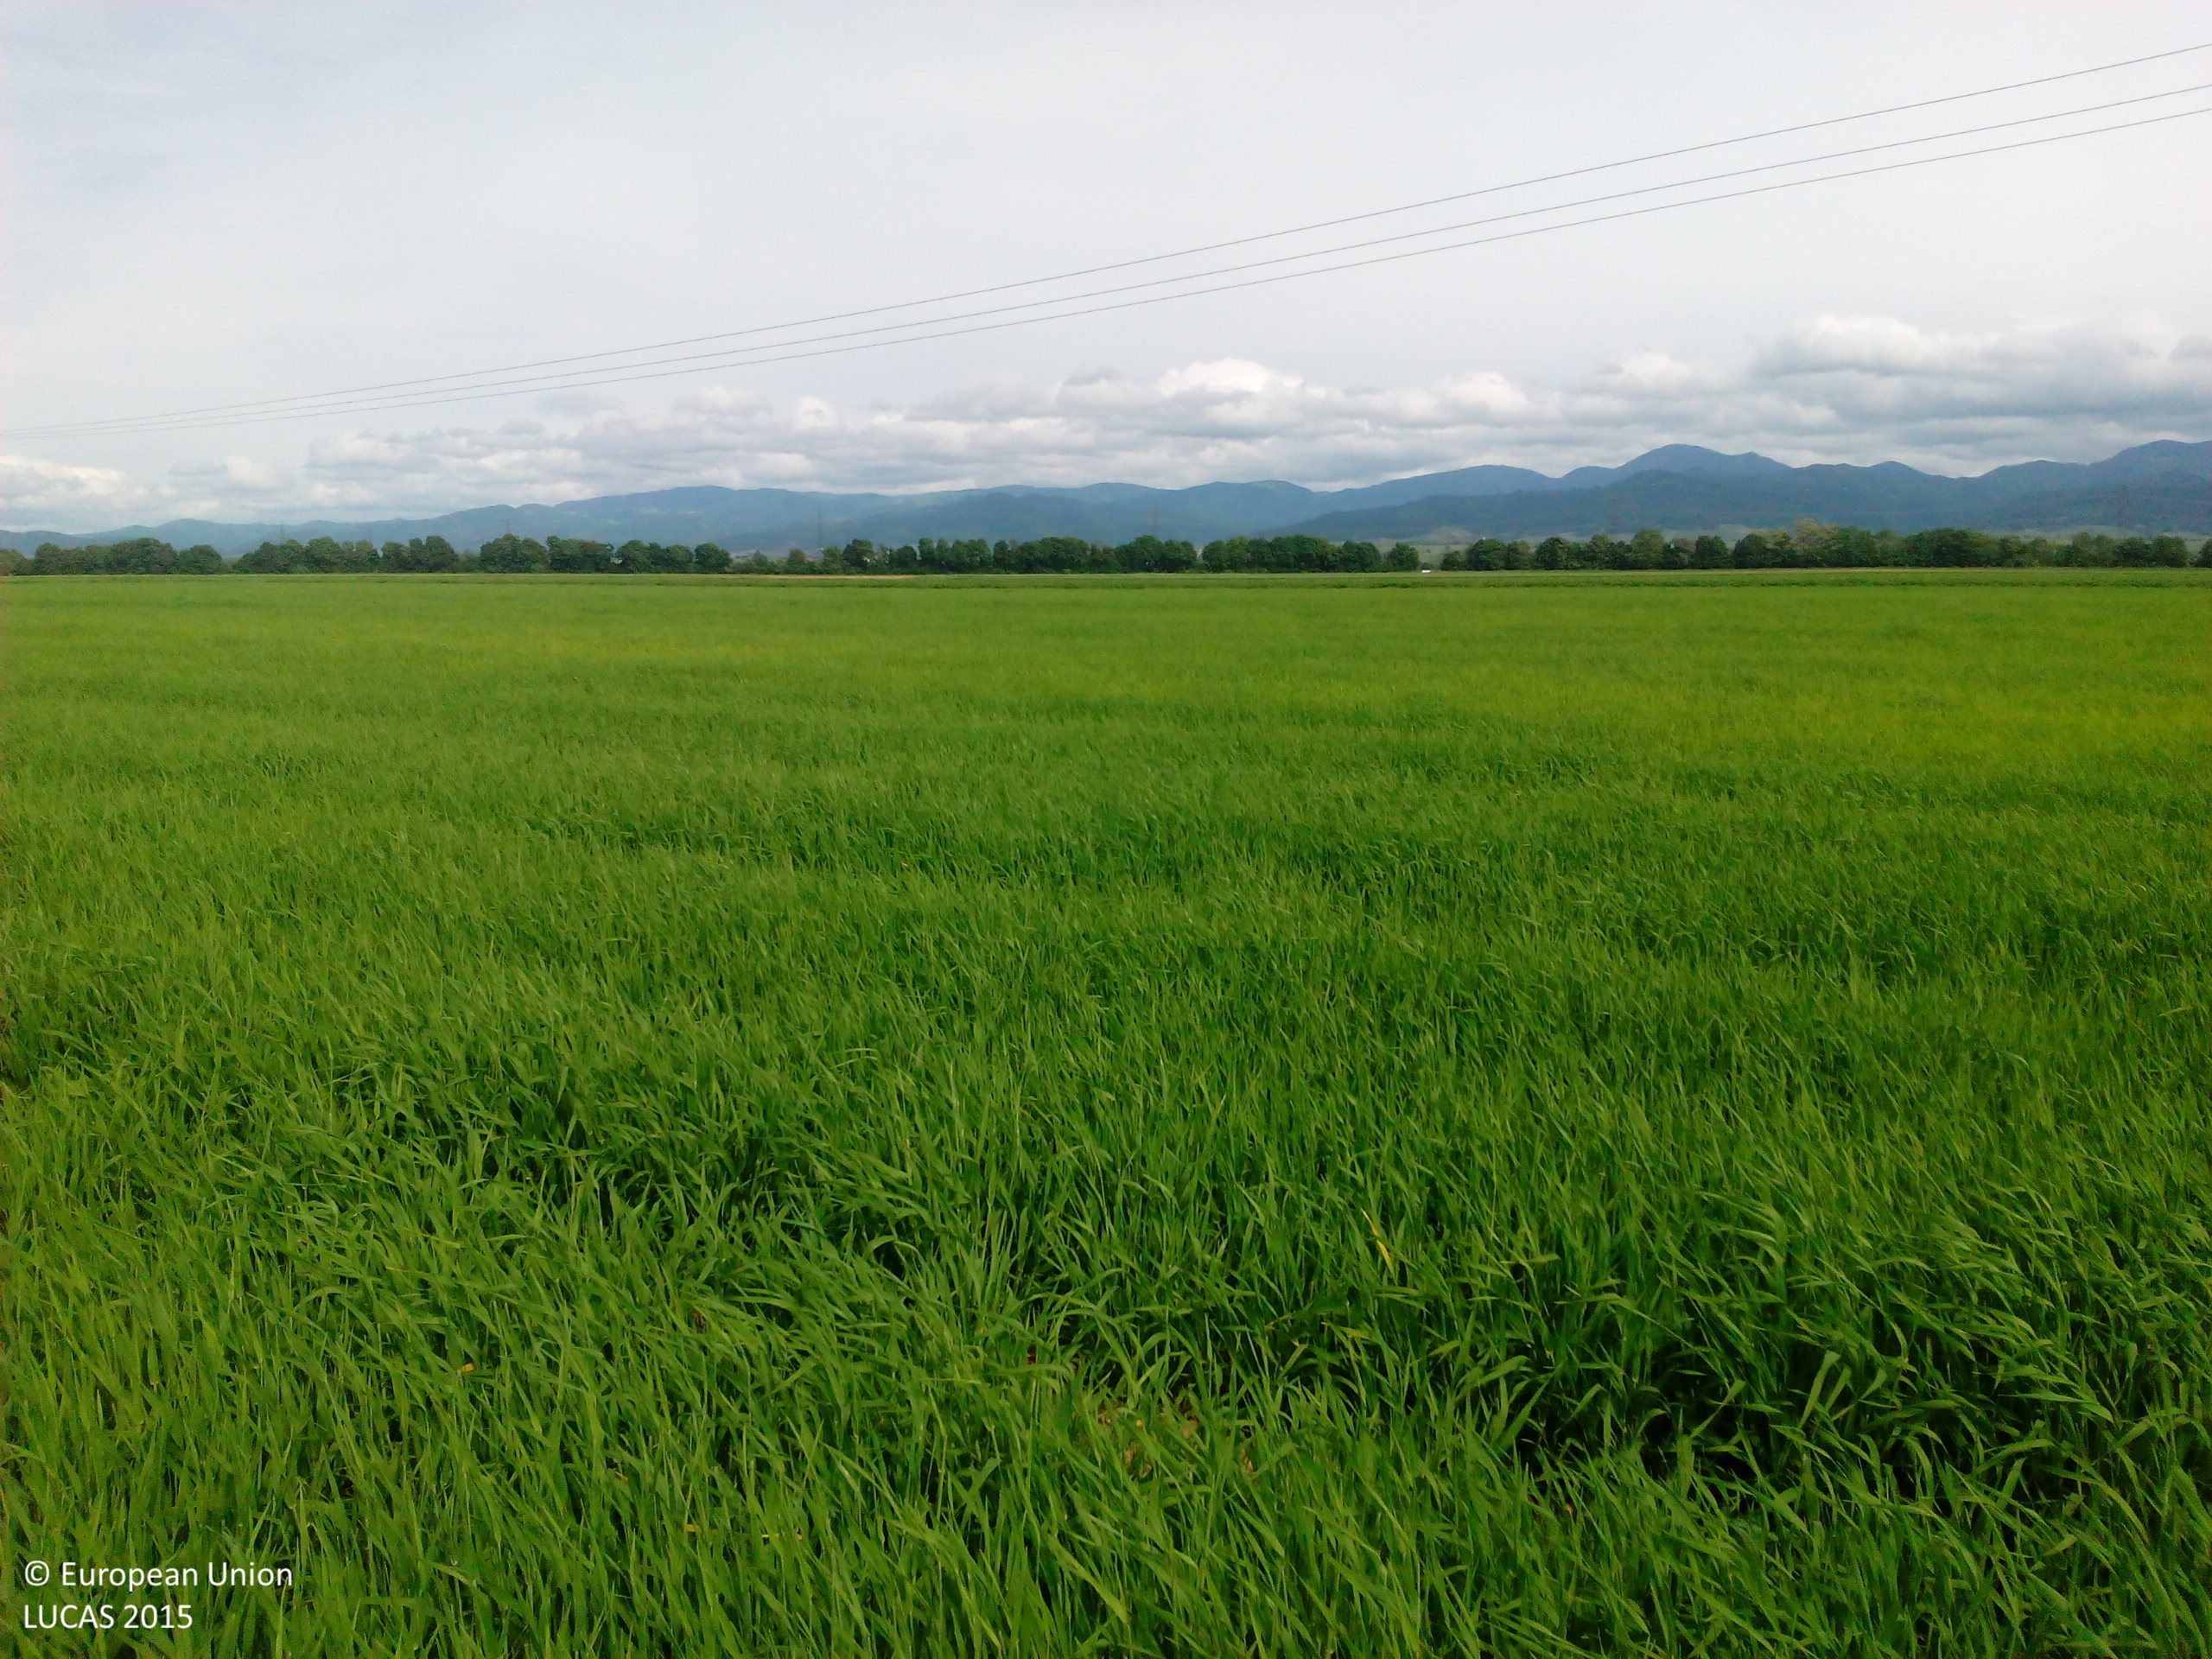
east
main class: Cropland
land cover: Barley
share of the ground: > 75 %
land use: Agriculture (excluding fallow land and kitchen gardens)
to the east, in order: Barley; Electric lines; Barley; Potatoes
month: May
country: DE
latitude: 47.8735
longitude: 7.6081
